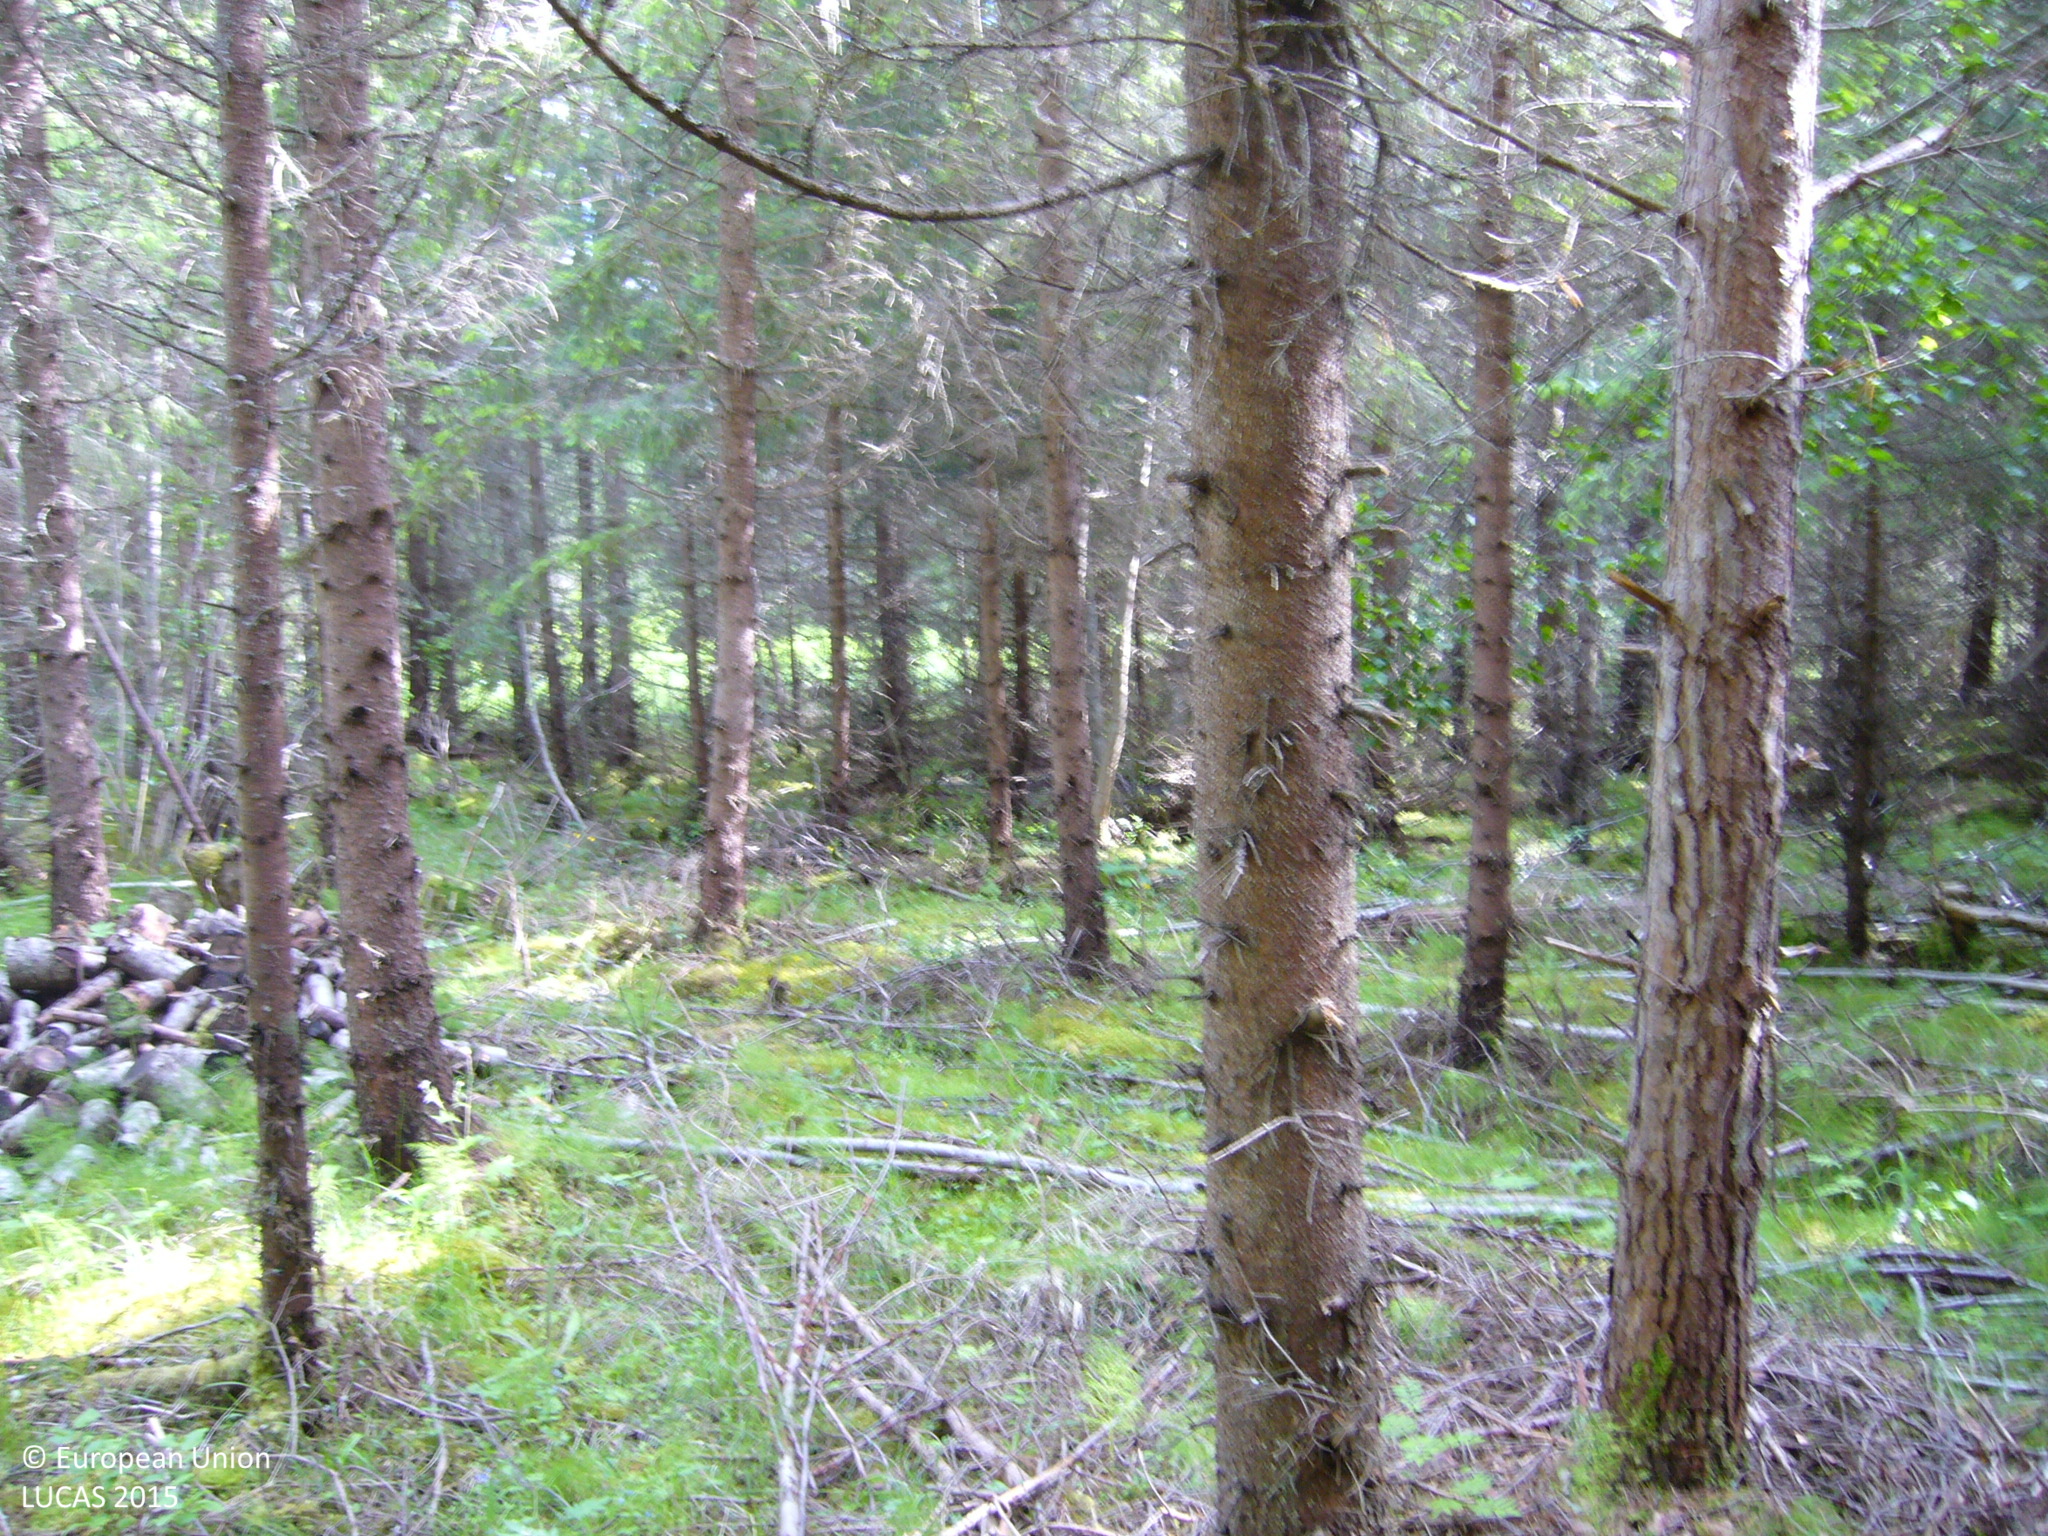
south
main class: Woodland
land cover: Spruce dominated coniferous woodland
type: boreal forest
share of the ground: > 75 %
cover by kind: coniferous forest trees 85 %, shrubs 10 %, broadleaved forest trees 5 %
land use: Forestry
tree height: > 5 m
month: July
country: FI
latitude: 63.5007
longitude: 26.2096
